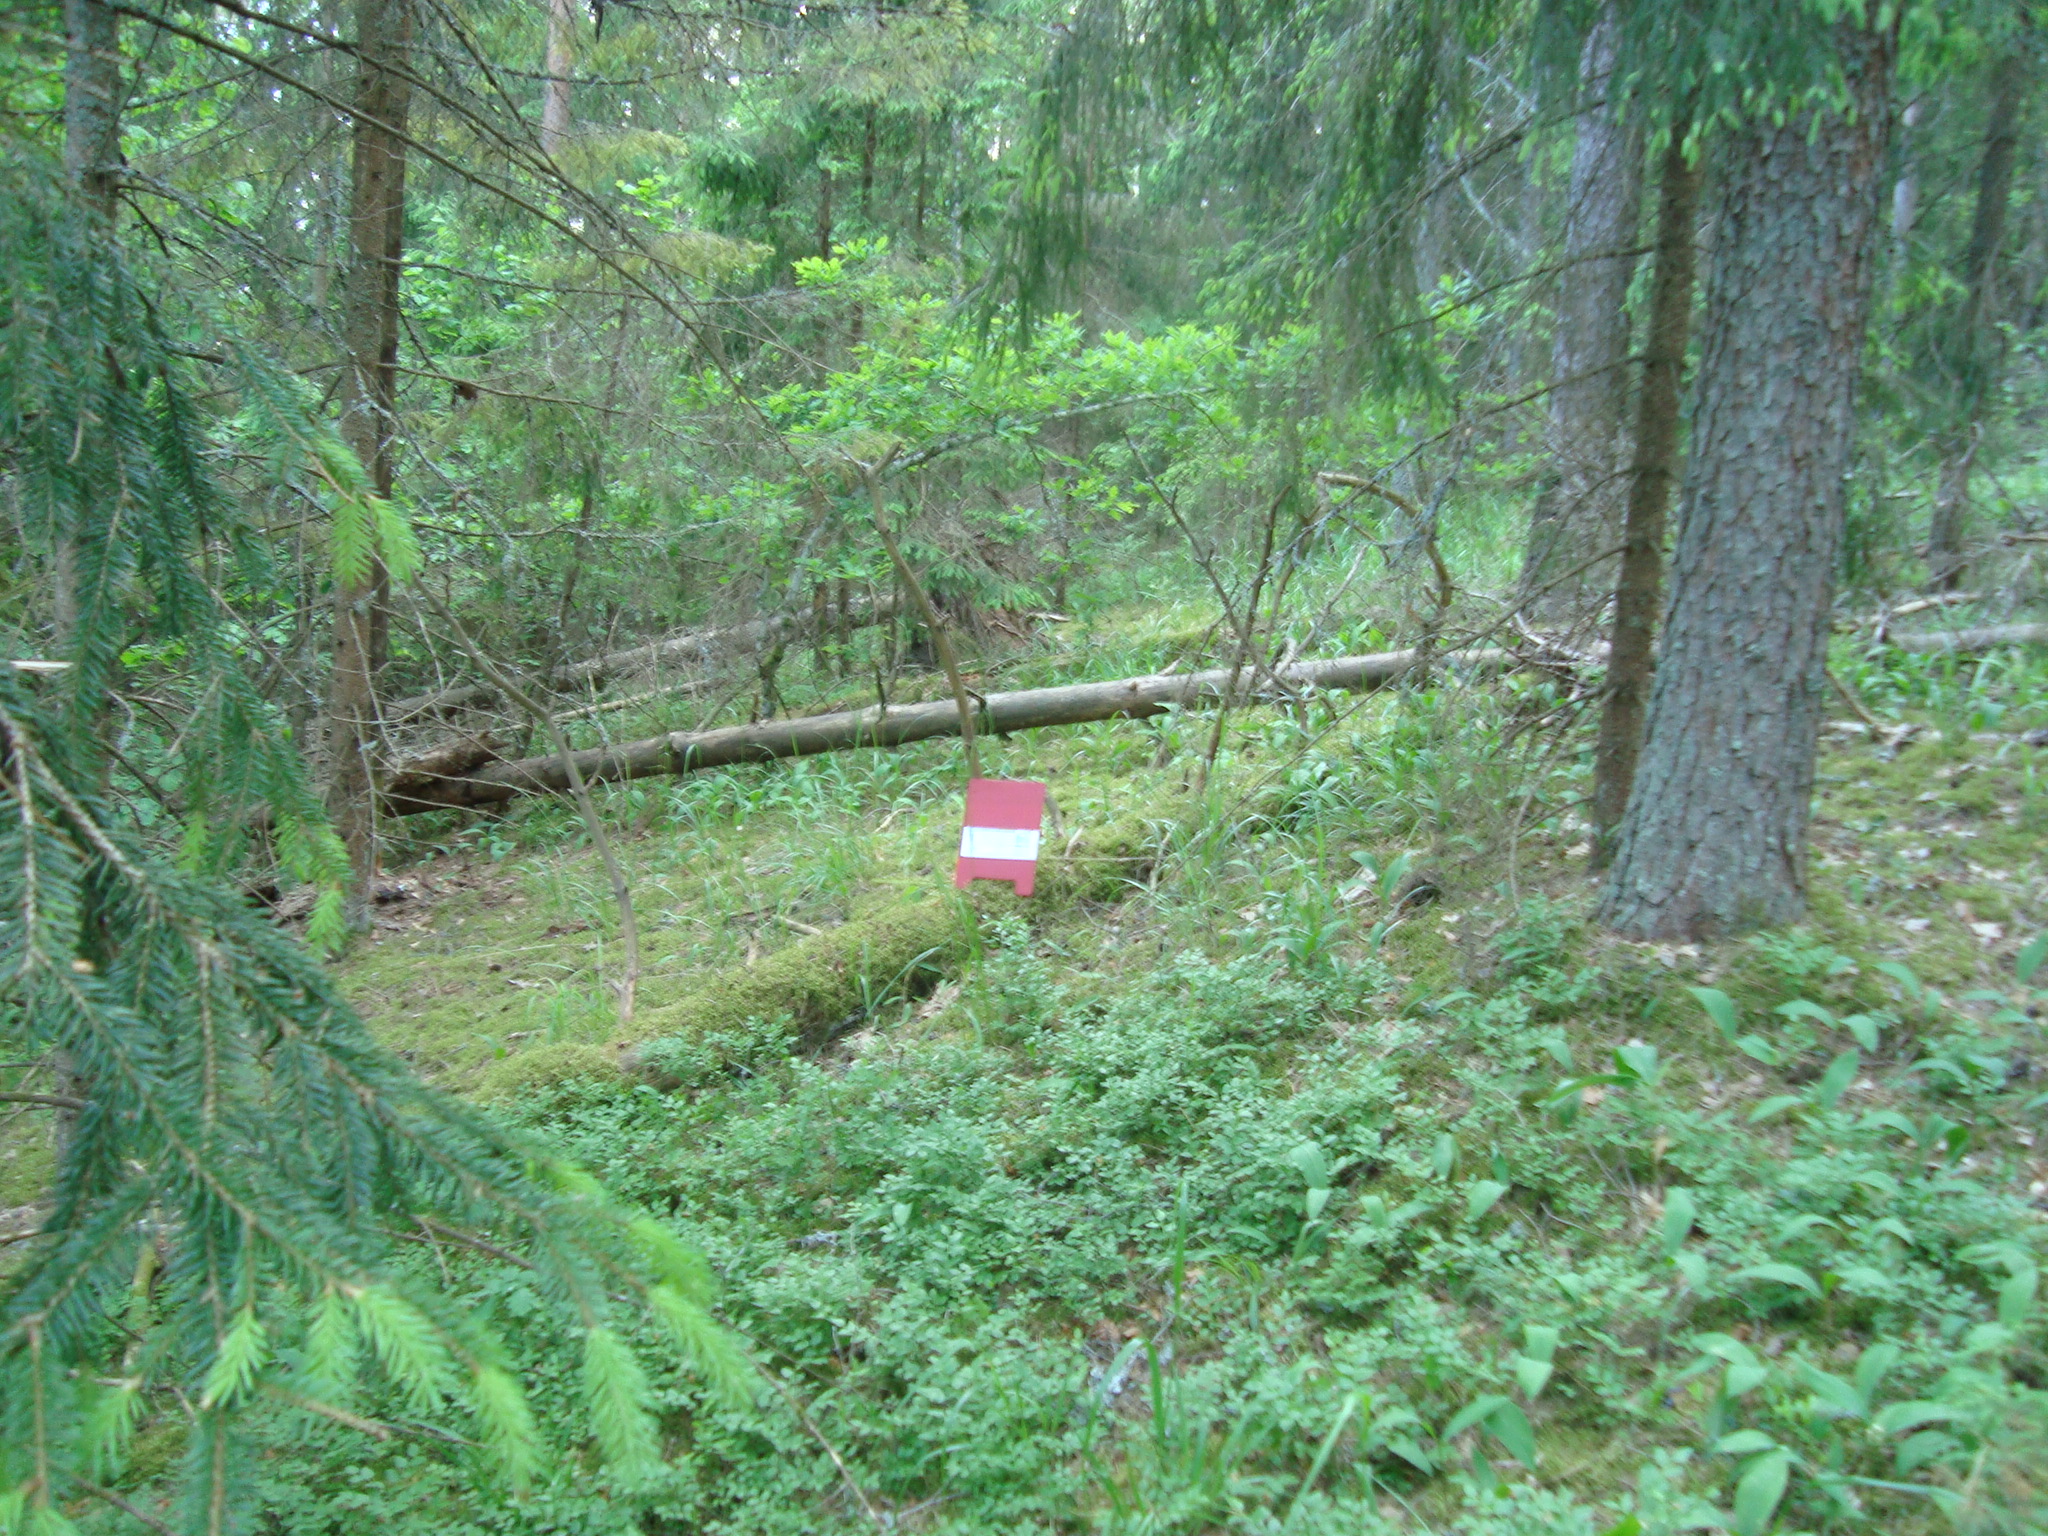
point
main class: Woodland
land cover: Spruce dominated coniferous woodland
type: hemiboreal forest and nemoral coniferous forest and mixed broadleaved-coniferous forest
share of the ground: > 75 %
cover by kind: coniferous forest trees 80 %, herbaceous plants 10 %, broadleaved forest trees 5 %, lichens and mosses 5 %
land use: Forestry
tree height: > 5 m
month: June
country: LV
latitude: 56.6934
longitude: 25.7523
